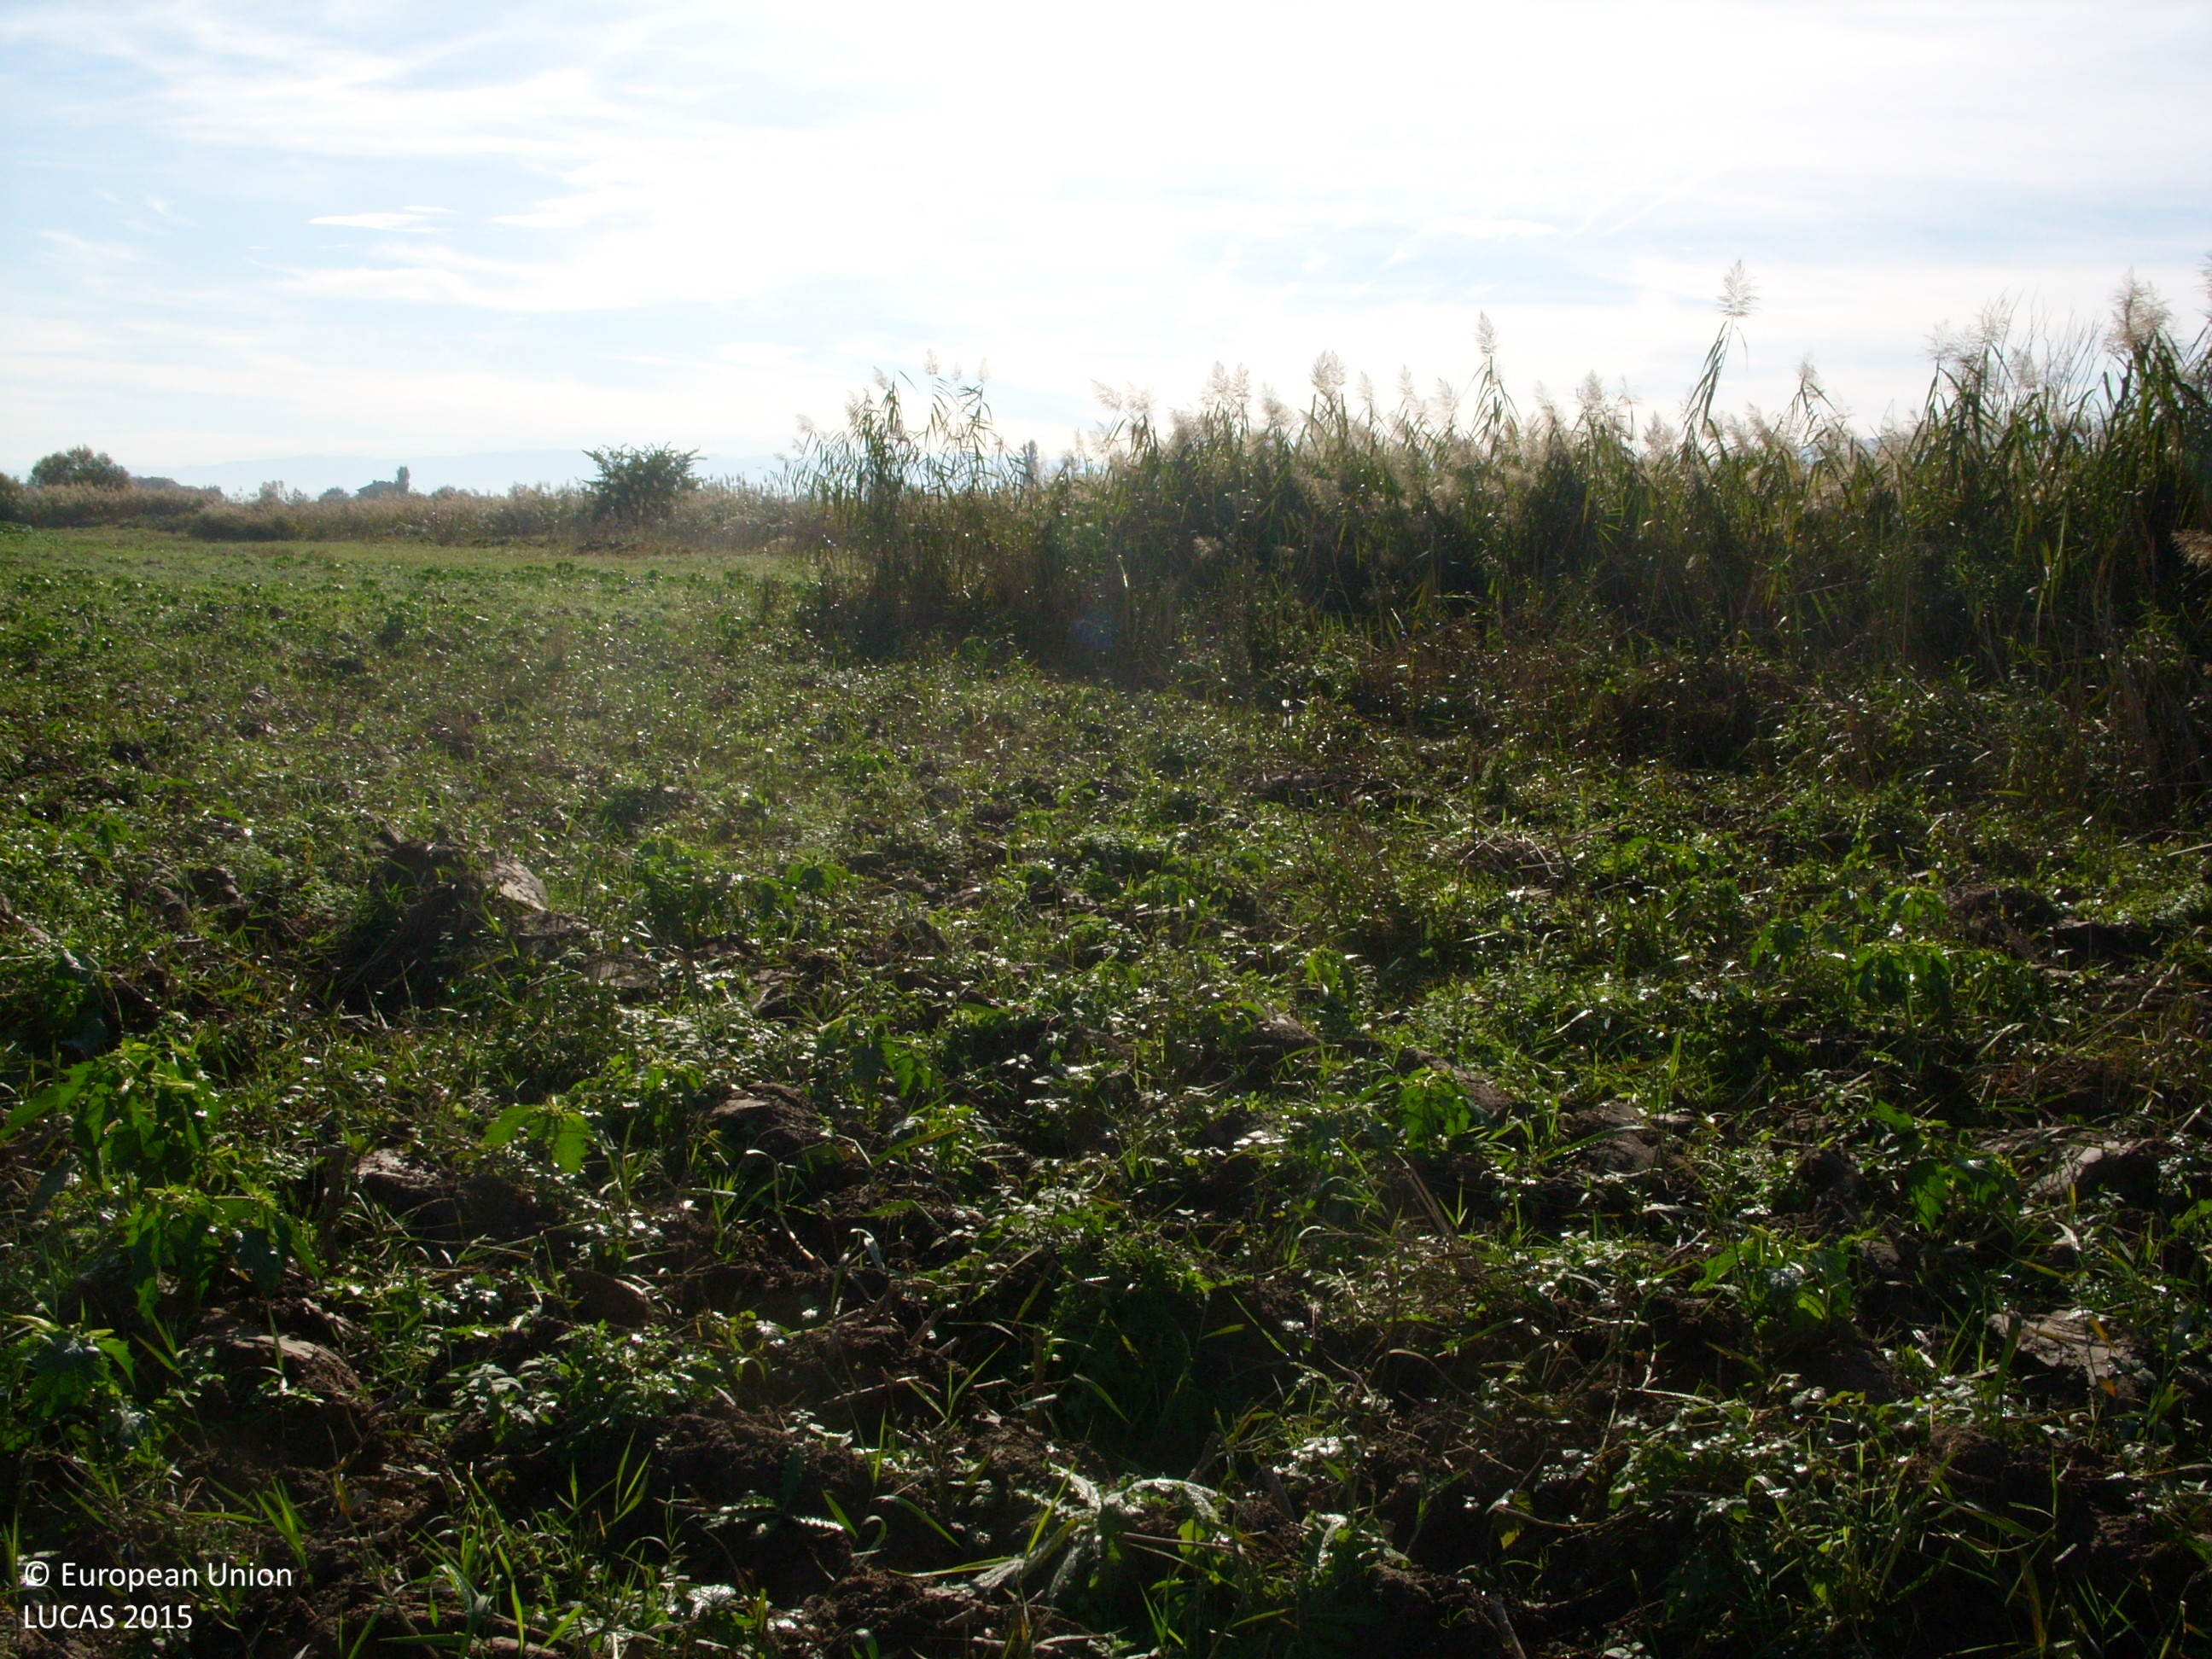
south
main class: Cropland
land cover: Barley
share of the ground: < 10 %
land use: Agriculture (excluding fallow land and kitchen gardens)
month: October
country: BG
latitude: 42.2216
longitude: 24.1560
